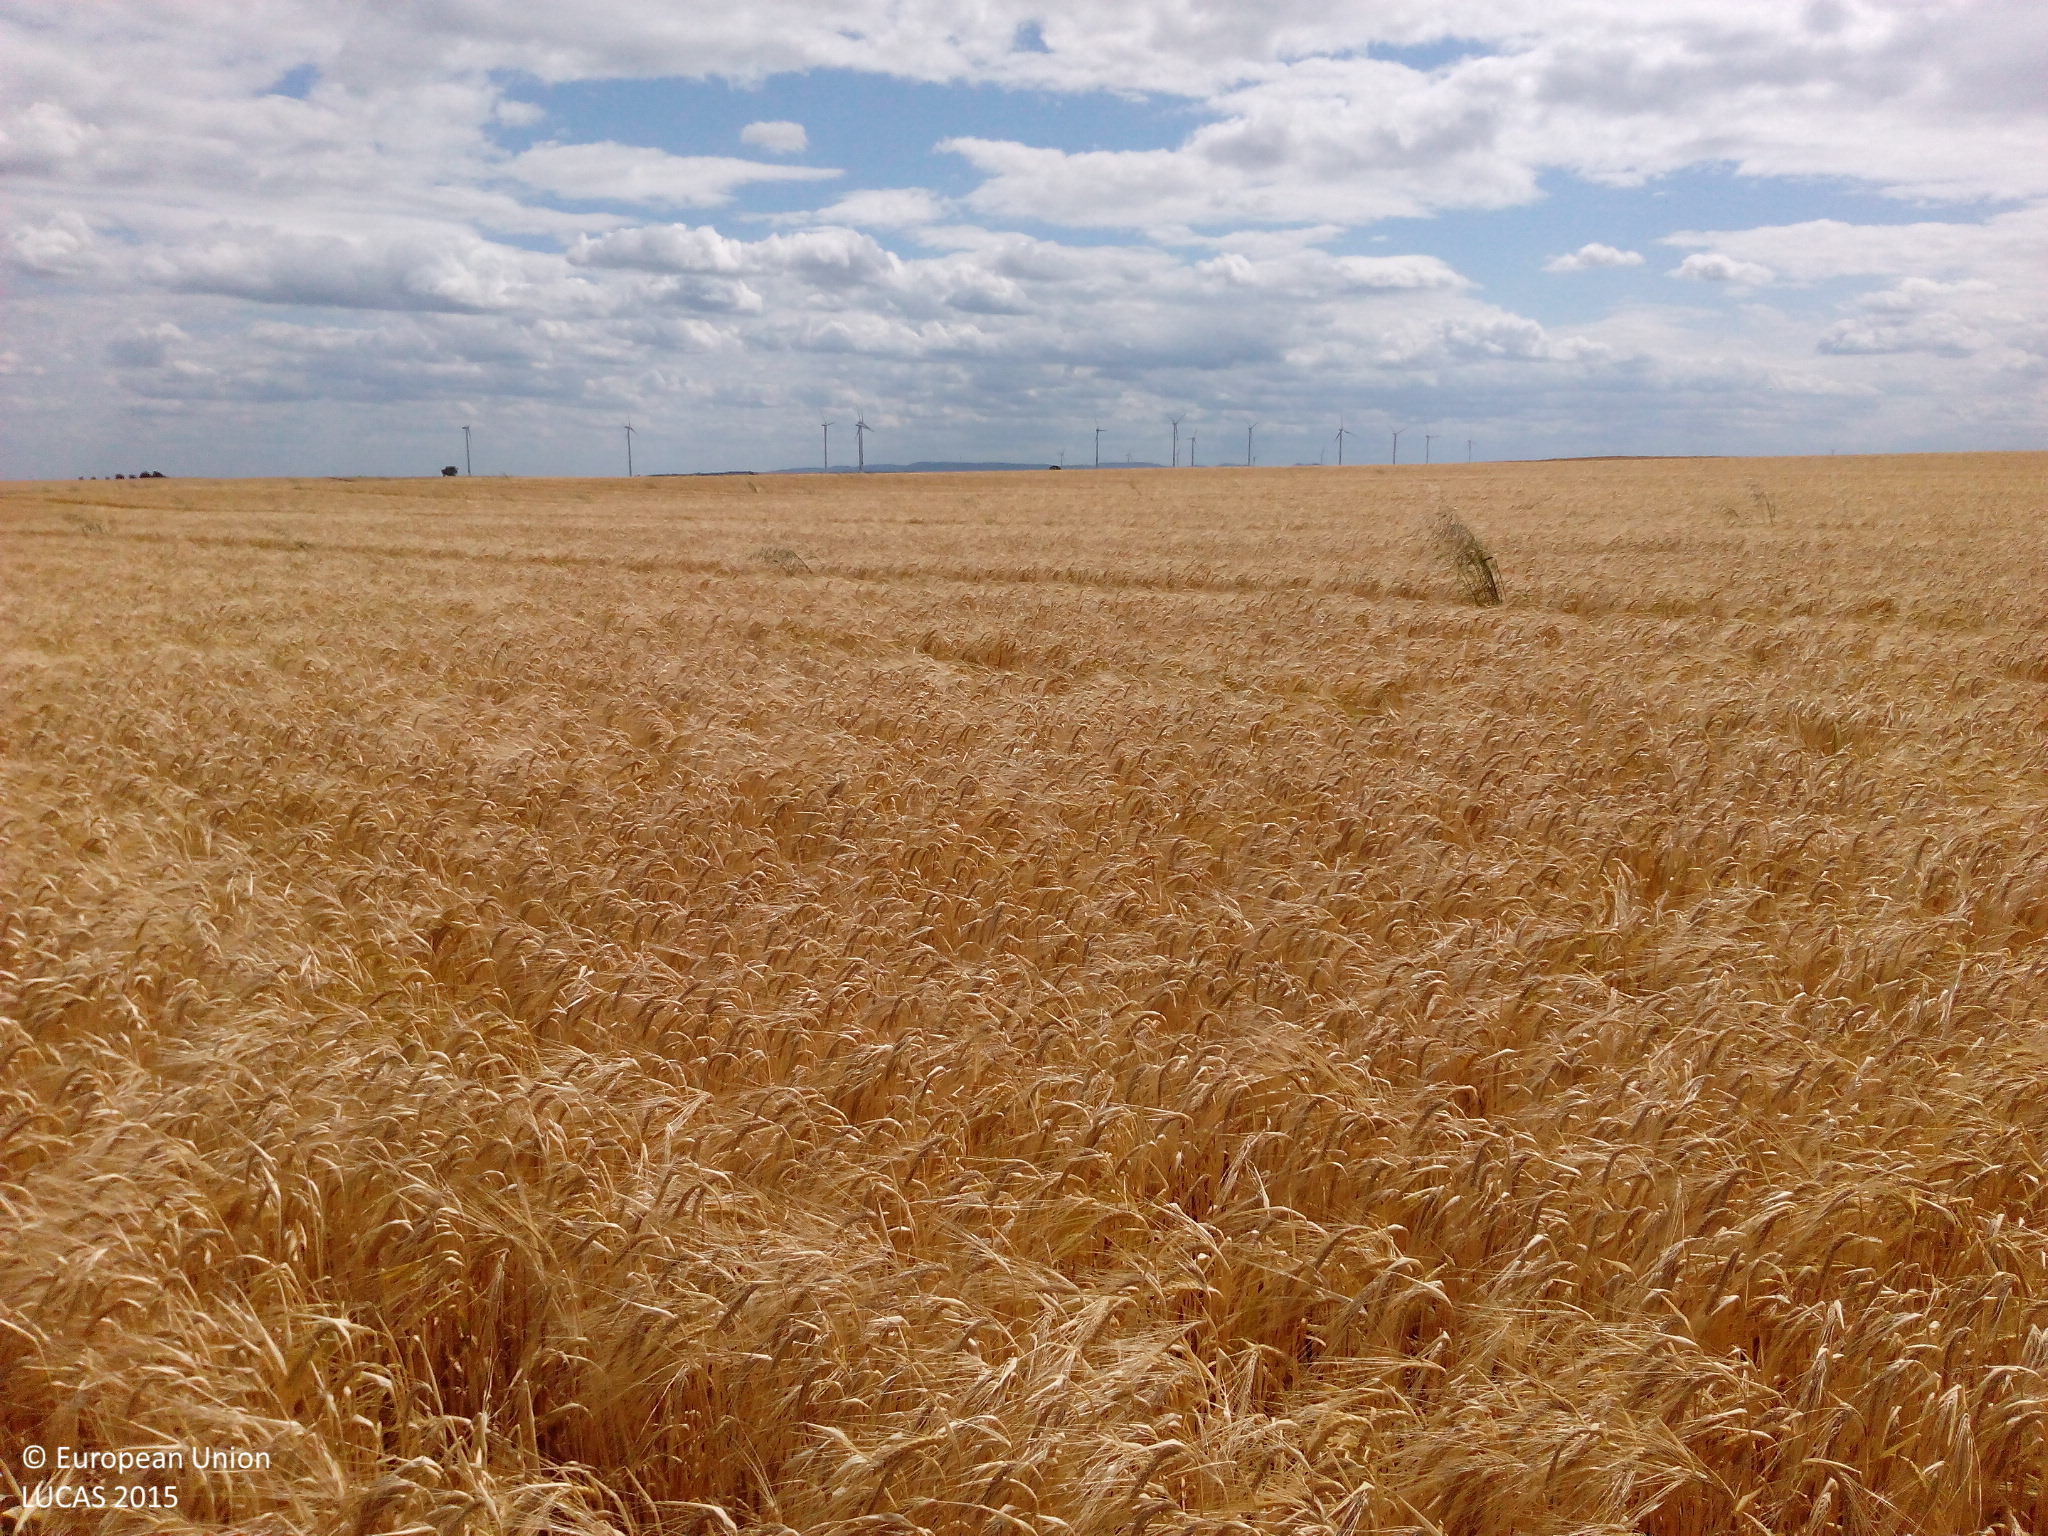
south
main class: Cropland
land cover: Barley
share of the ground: > 75 %
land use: Agriculture (excluding fallow land and kitchen gardens)
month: July
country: DE
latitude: 49.6657
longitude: 8.1578
